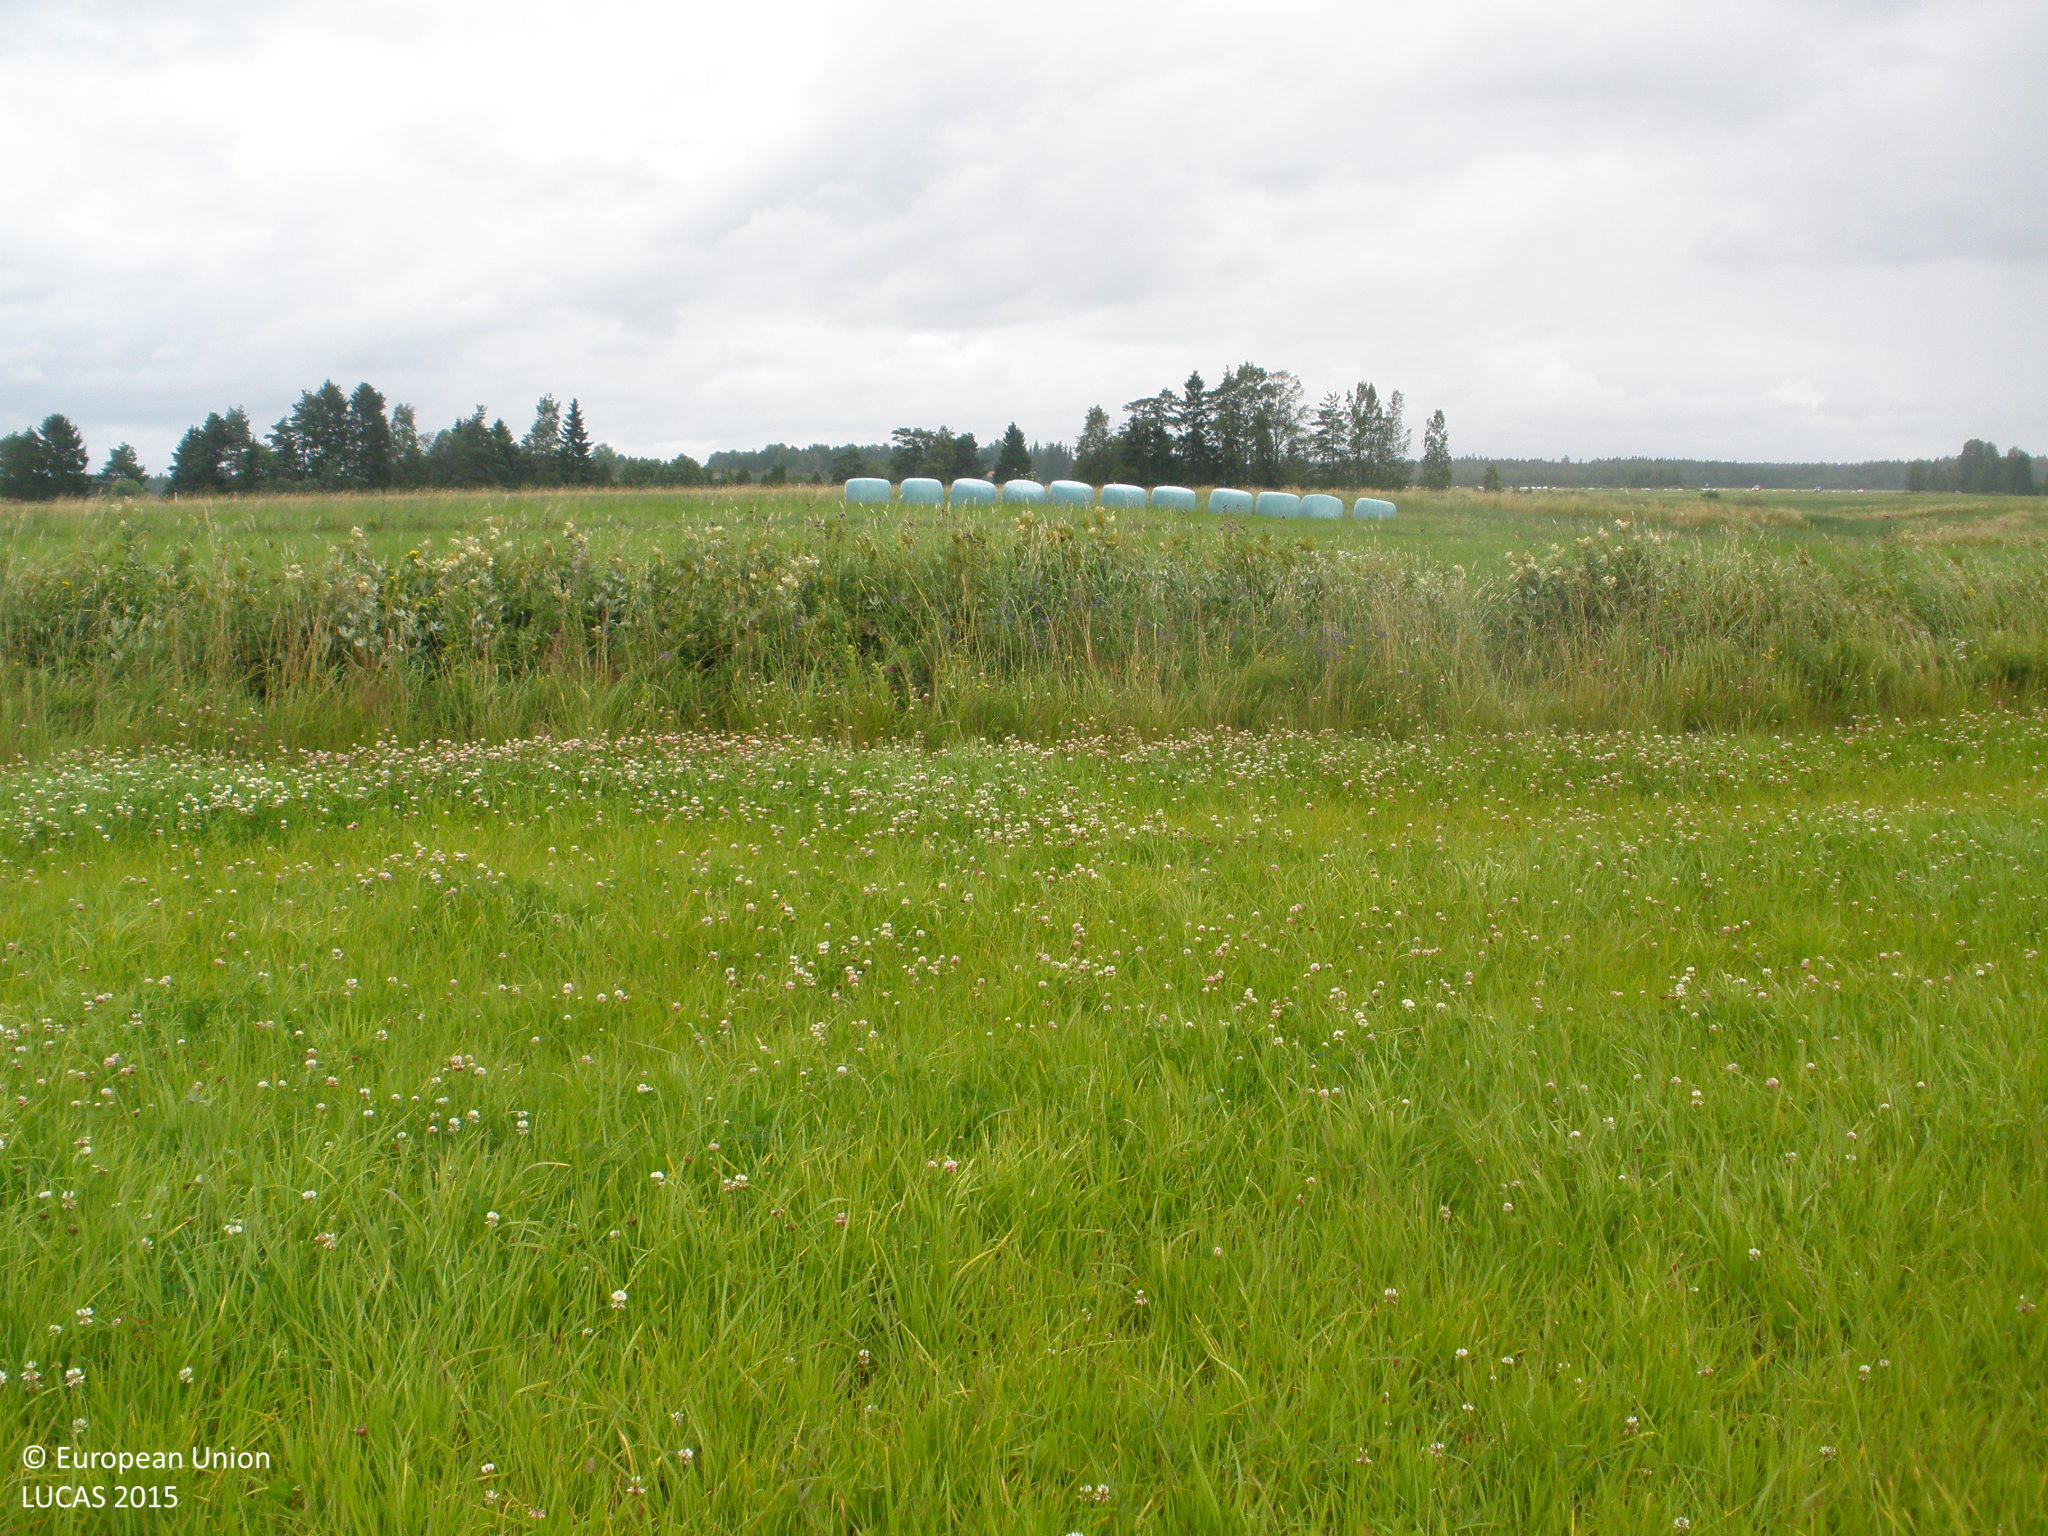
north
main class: Cropland
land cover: Temporary grasslands
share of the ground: > 75 %
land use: Agriculture (excluding fallow land and kitchen gardens)
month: July
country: FI
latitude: 60.5464
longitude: 23.3750
